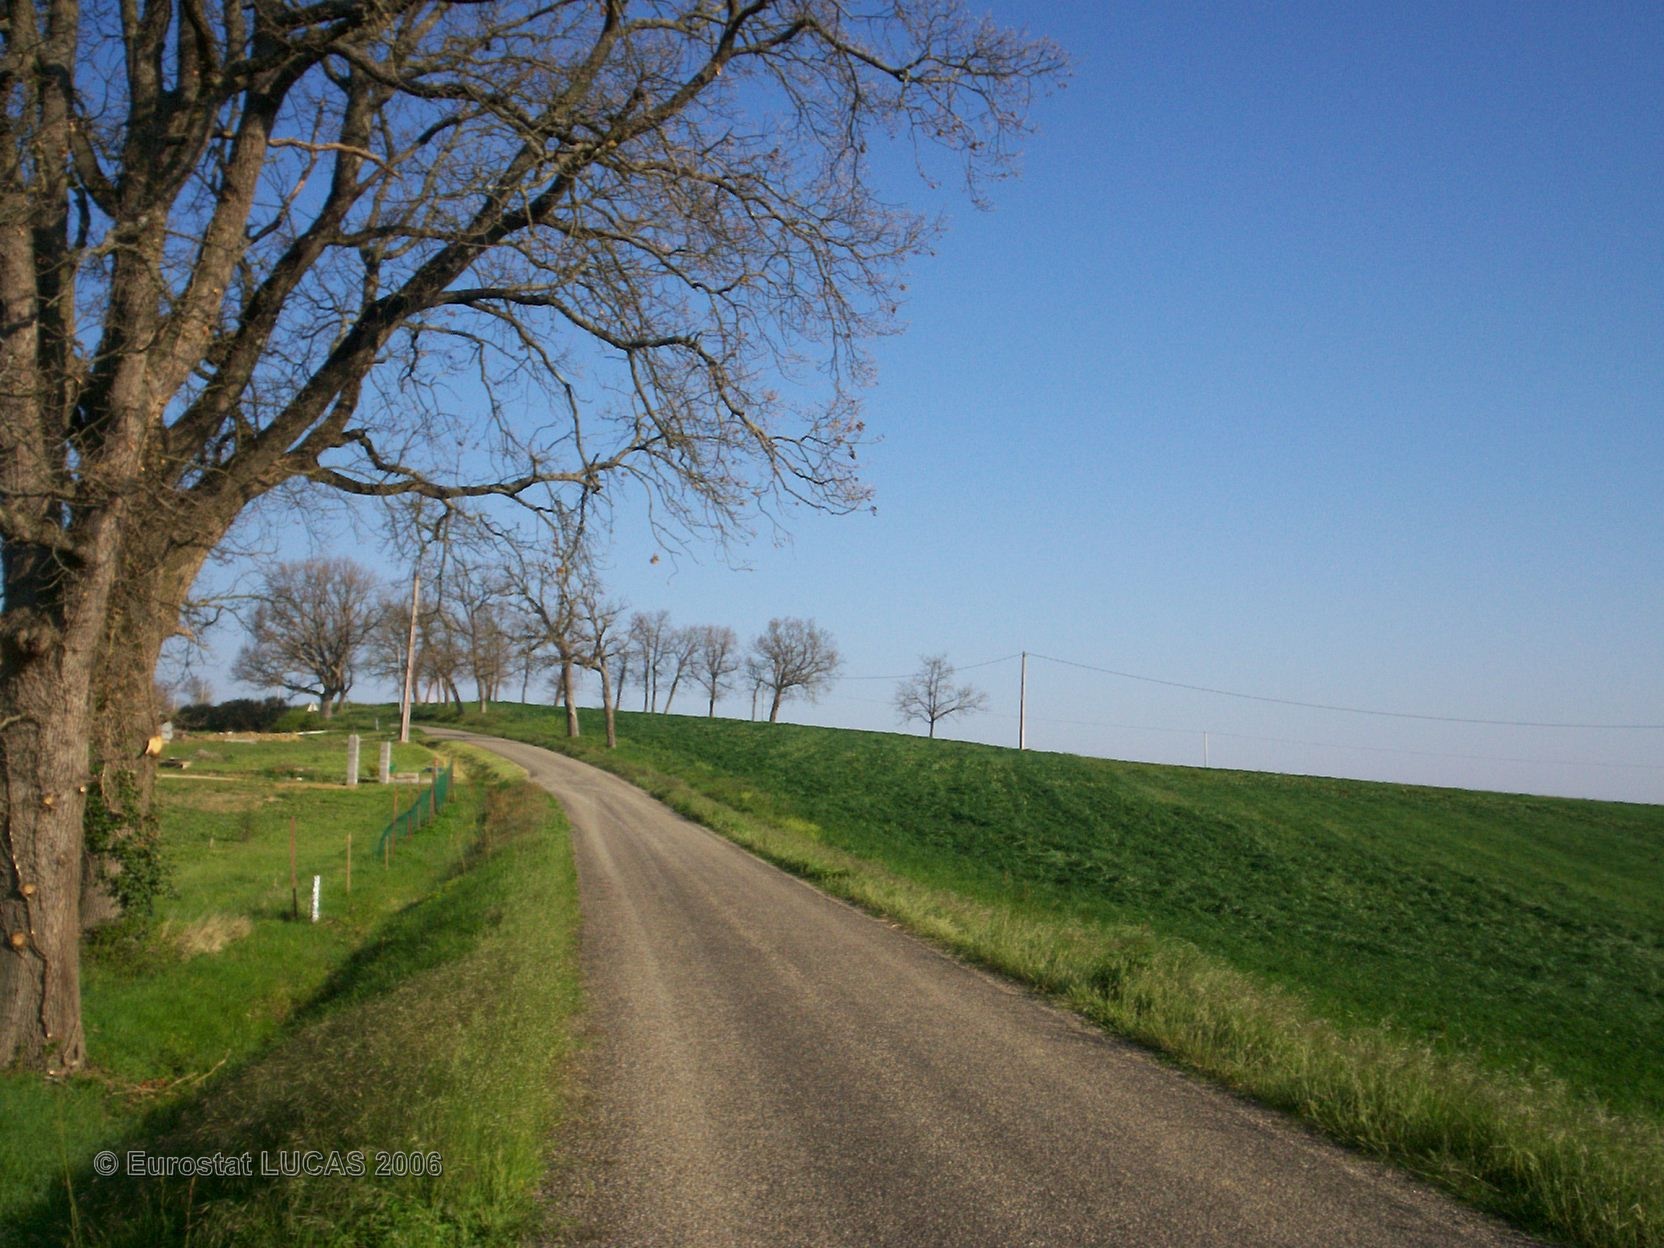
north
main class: Cropland
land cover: Barley
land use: Agriculture (excluding fallow land and kitchen gardens)
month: April
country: FR
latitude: 43.9399
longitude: 0.9910
